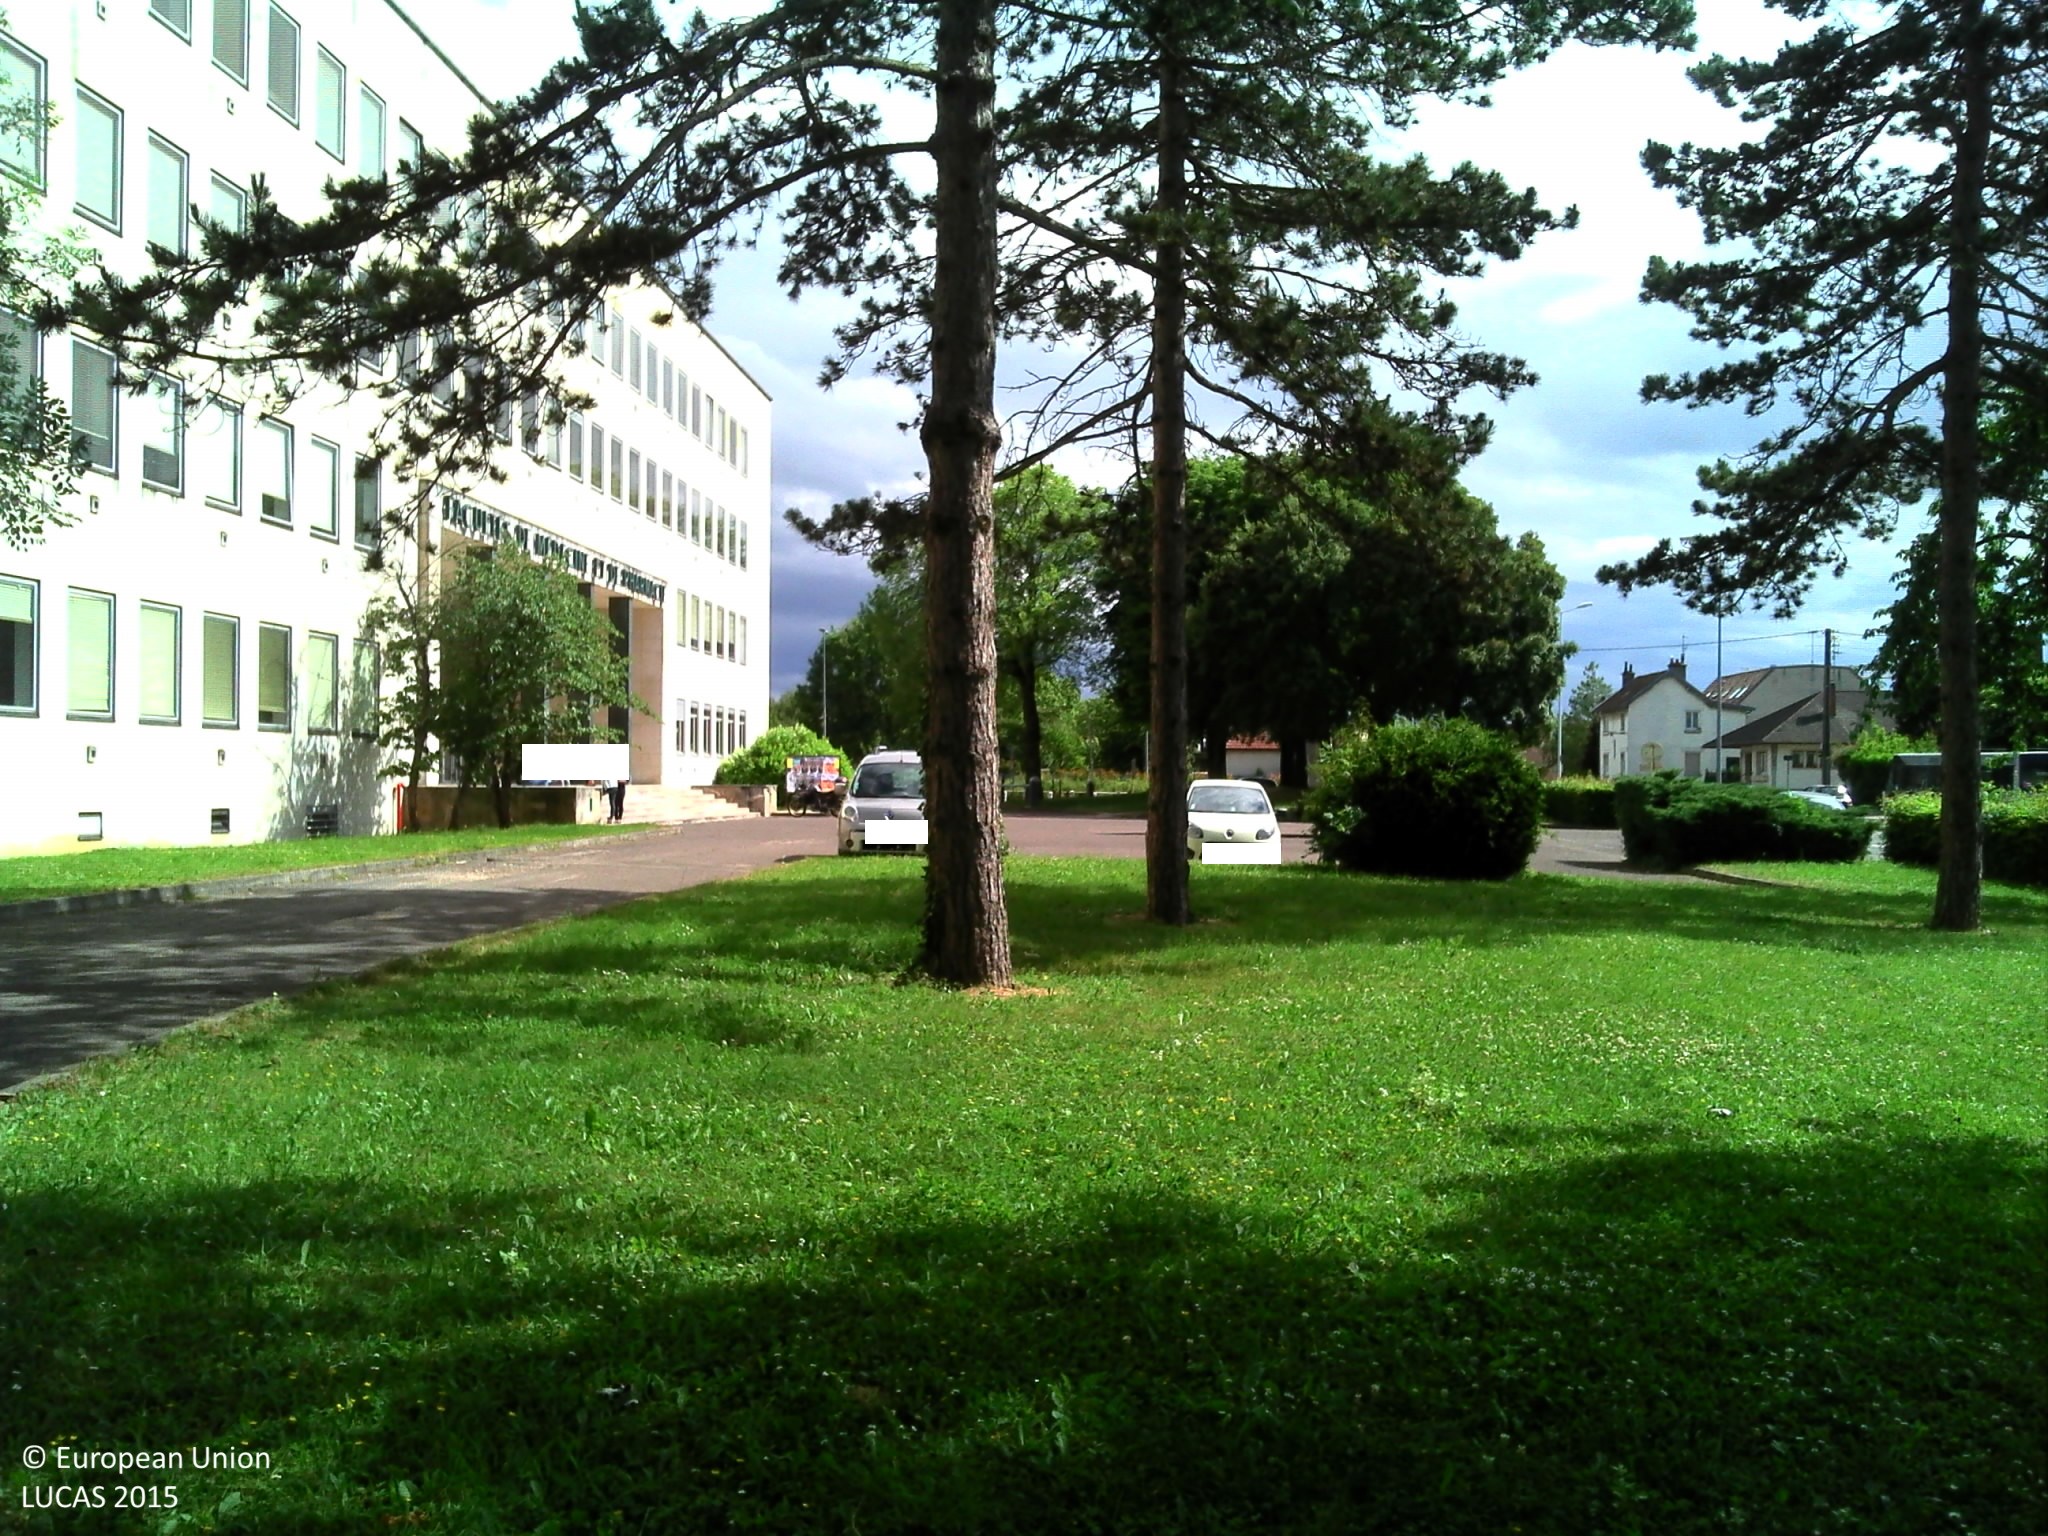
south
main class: Woodland
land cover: Pine dominated mixed woodland
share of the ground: > 75 %
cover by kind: herbaceous plants 65 %, coniferous forest trees 20 %, broadleaved forest trees 15 %
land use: Community services
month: June
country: FR
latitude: 47.3197
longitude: 5.0657
